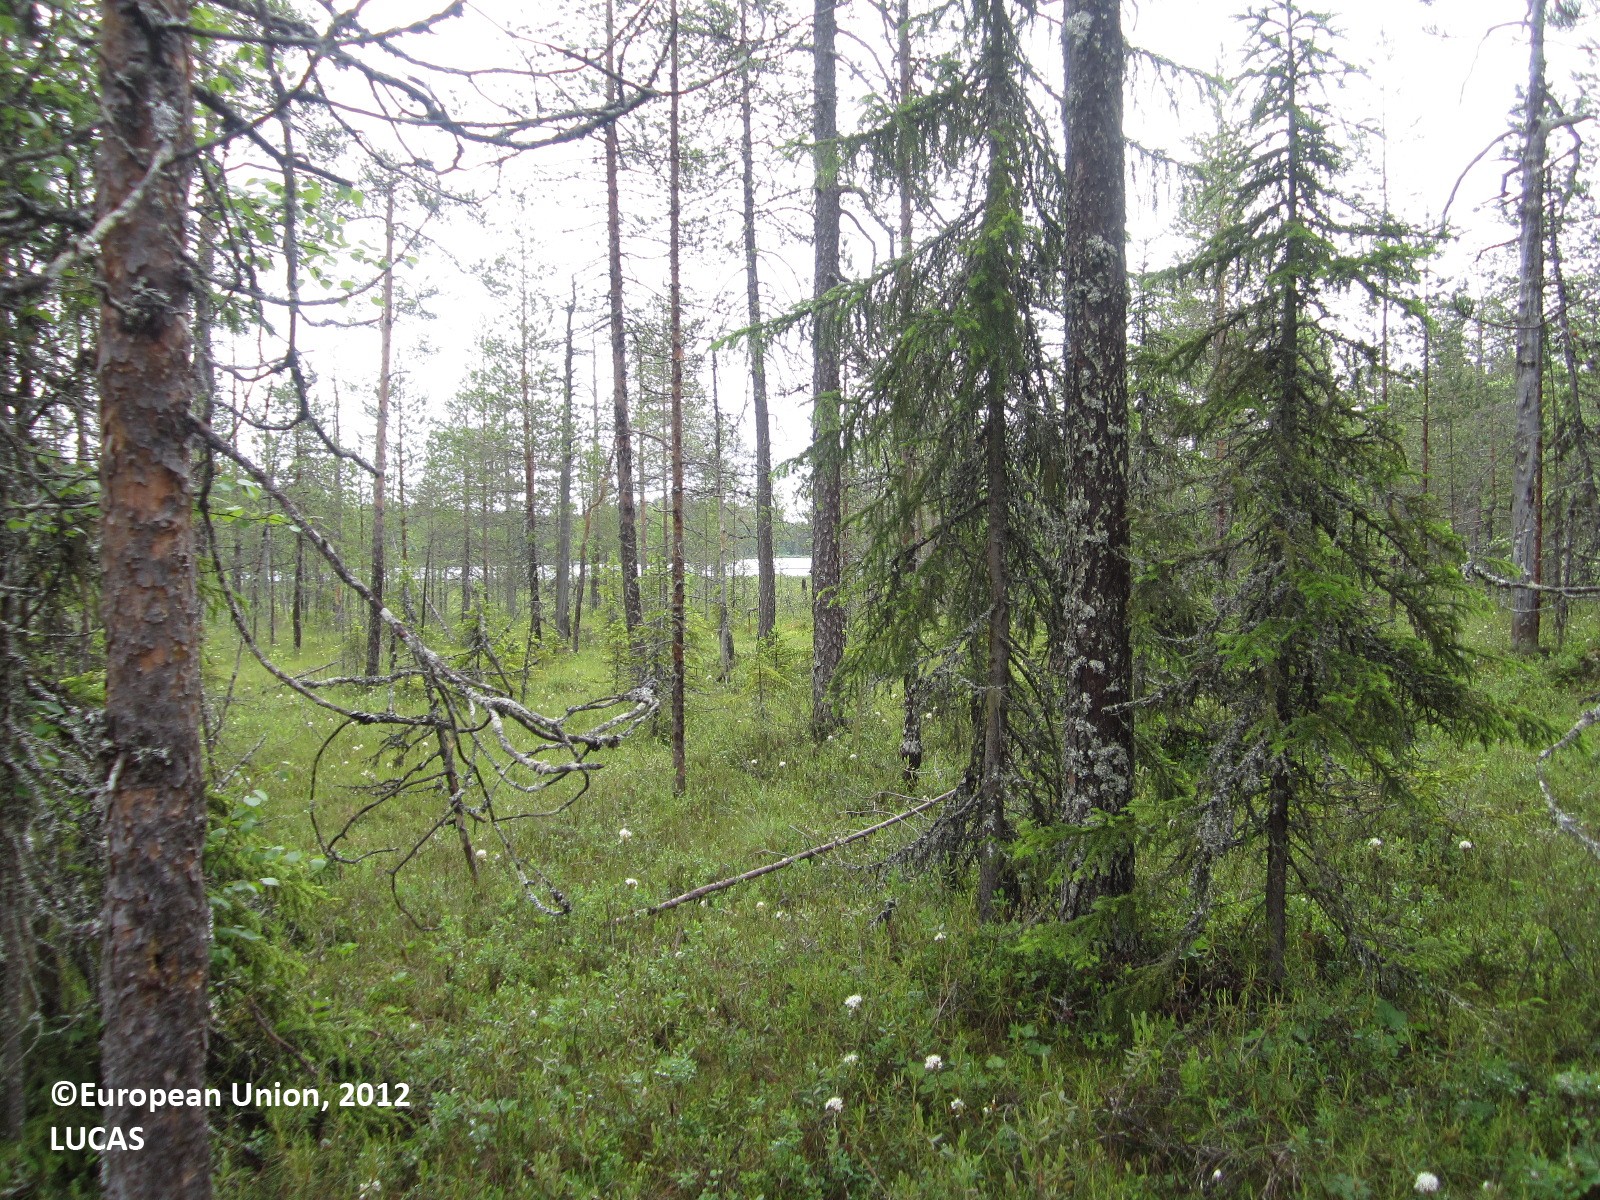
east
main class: Woodland
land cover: Spruce dominated coniferous woodland
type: mire and swamp forests
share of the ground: 50 - 75 %
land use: Forestry
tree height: > 5 m
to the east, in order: Spruce dominated coniferous woodland; Ditches and canals; Spruce dominated coniferous woodland; Pine dominated coniferous woodland; Peatbogs; Inland water bodies
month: June
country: FI
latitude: 64.5441
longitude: 29.5879
